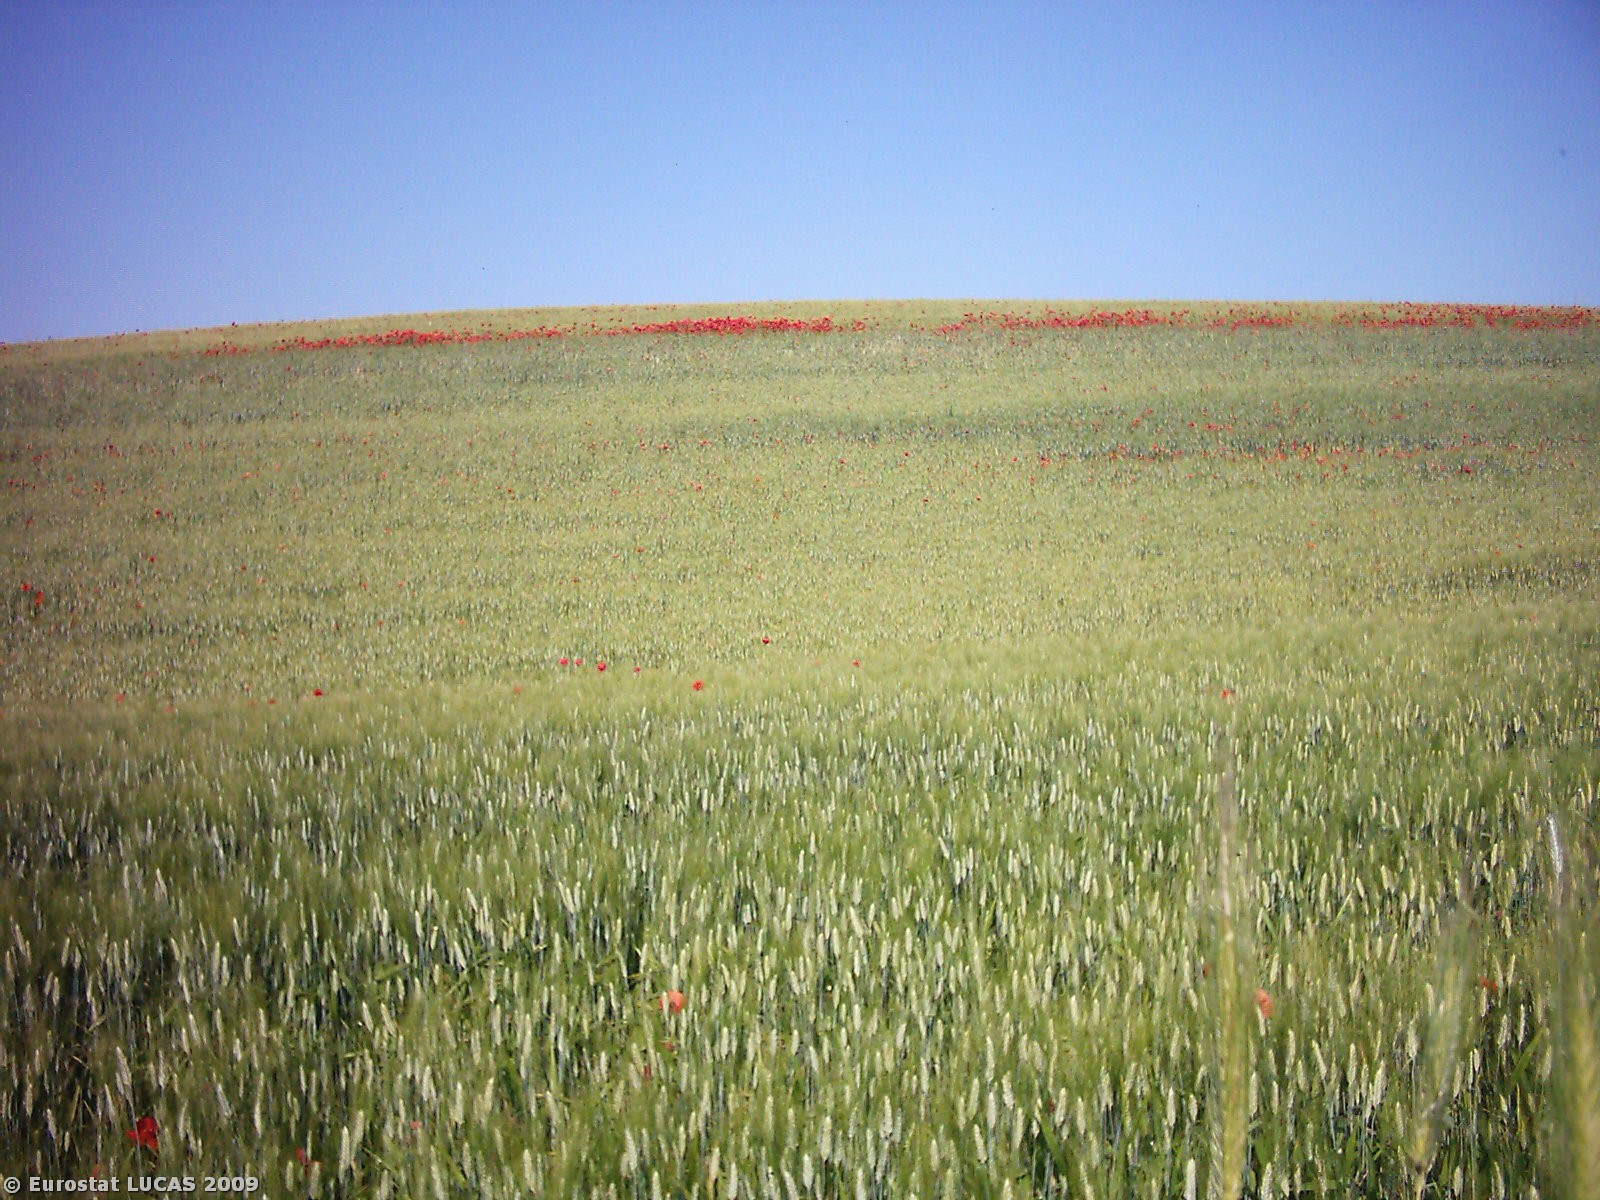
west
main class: Cropland
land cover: Durum wheat
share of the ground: > 75 %
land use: Agriculture (excluding fallow land and kitchen gardens)
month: May
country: IT
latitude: 41.1623
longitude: 15.8556
